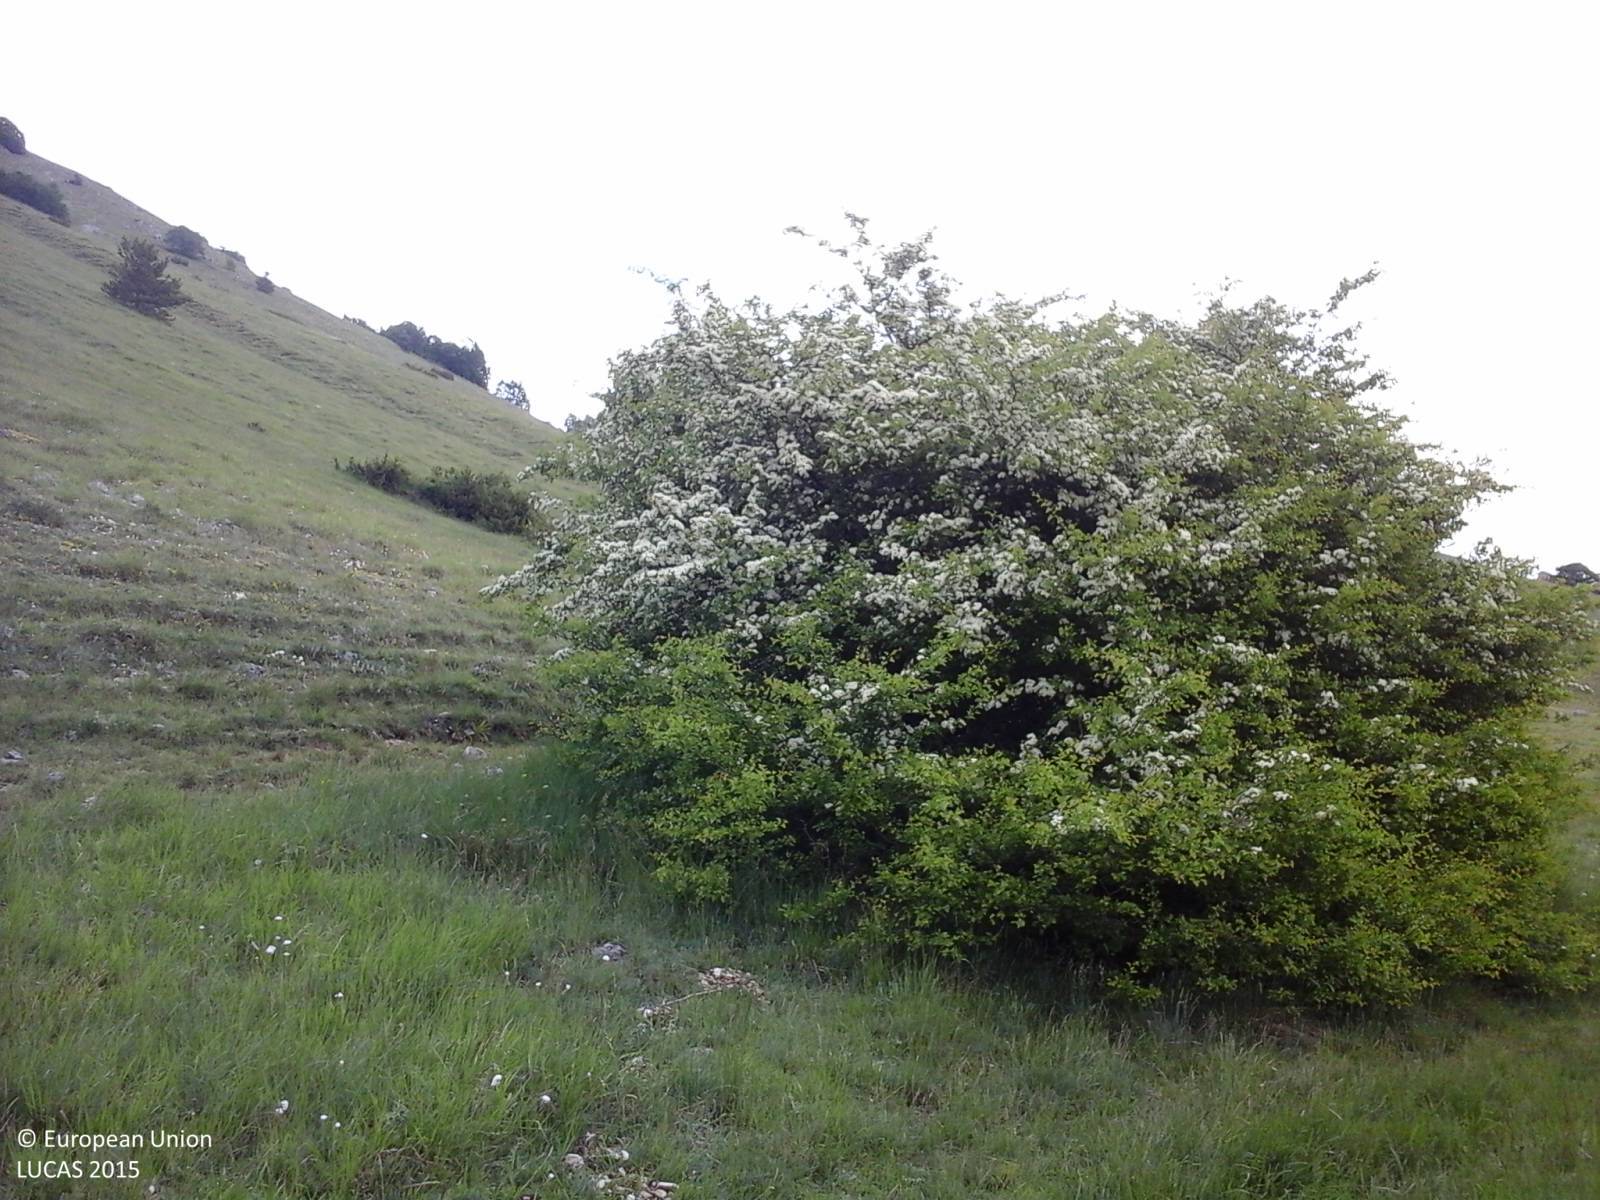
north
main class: Grassland
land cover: Grassland without tree/shrub cover
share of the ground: > 75 %
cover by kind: herbaceous plants 95 %, shrubs 5 %
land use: Agriculture (excluding fallow land and kitchen gardens)
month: June
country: IT
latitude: 41.9019
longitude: 14.0967
